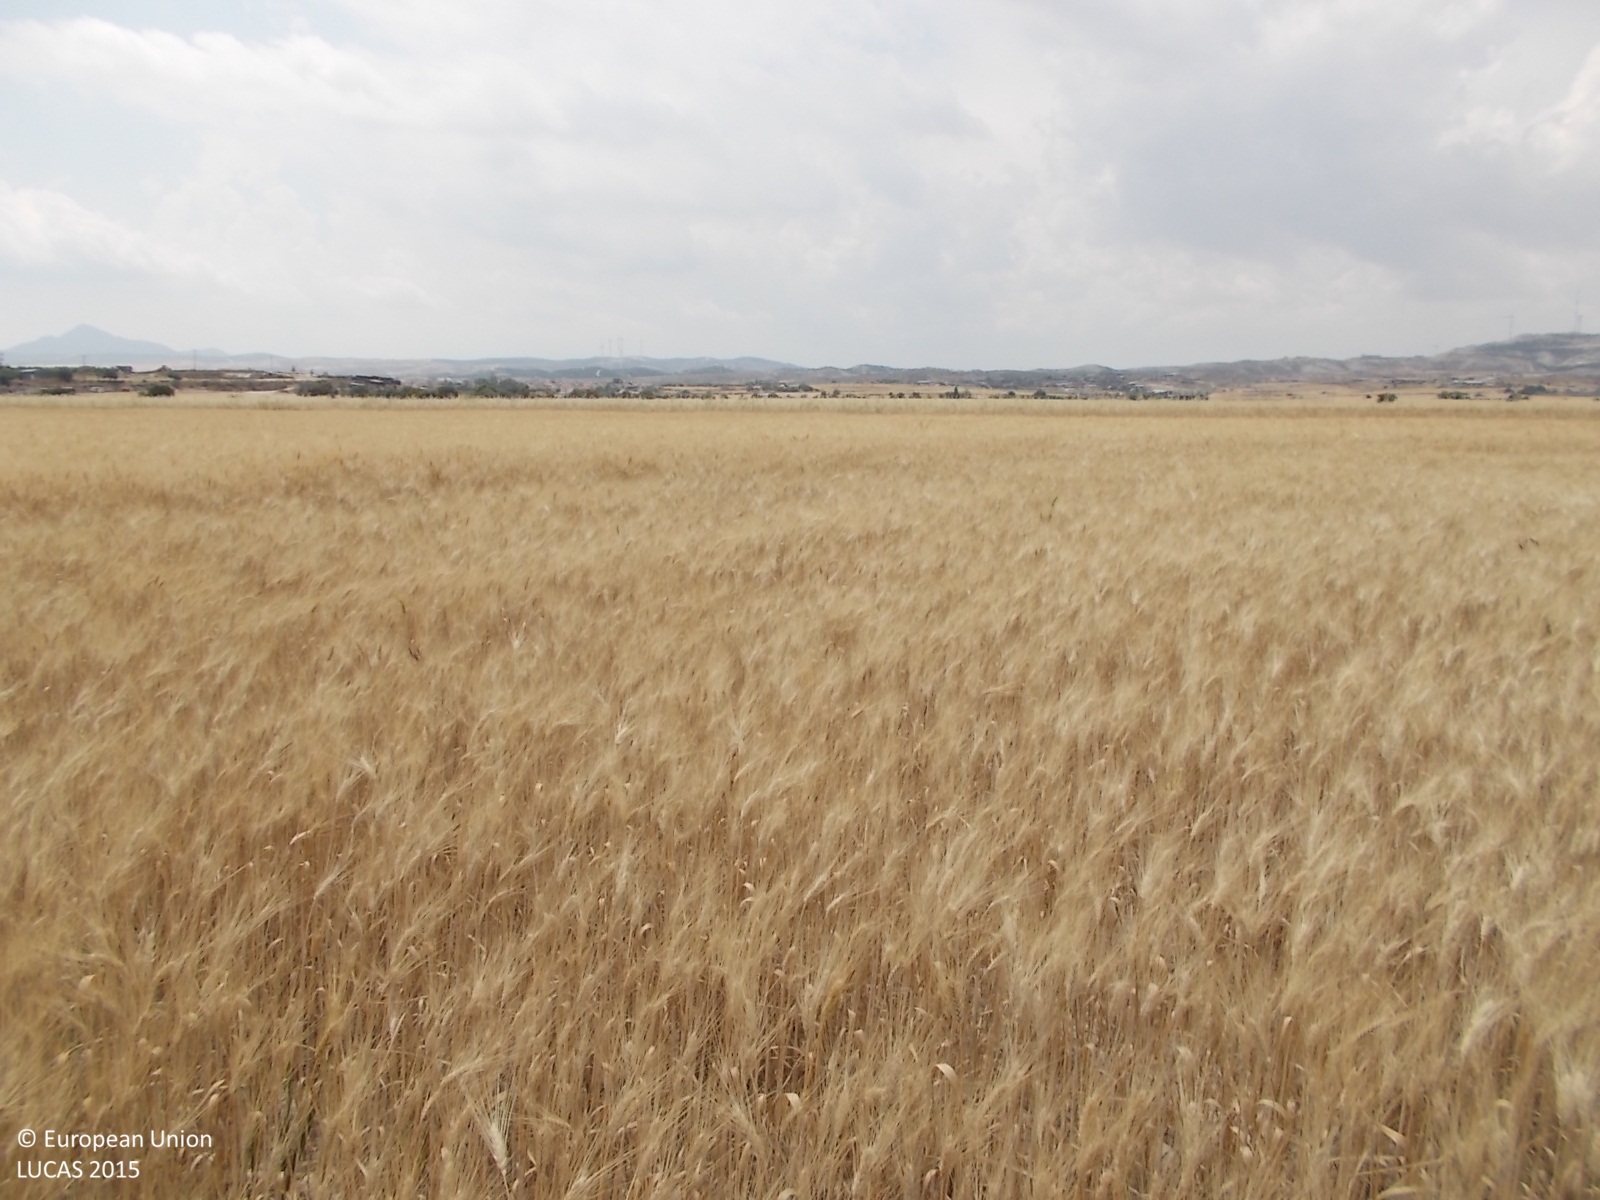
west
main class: Cropland
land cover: Durum wheat
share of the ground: > 75 %
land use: Agriculture (excluding fallow land and kitchen gardens)
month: May
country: CY
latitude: 34.9343
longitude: 33.5457
